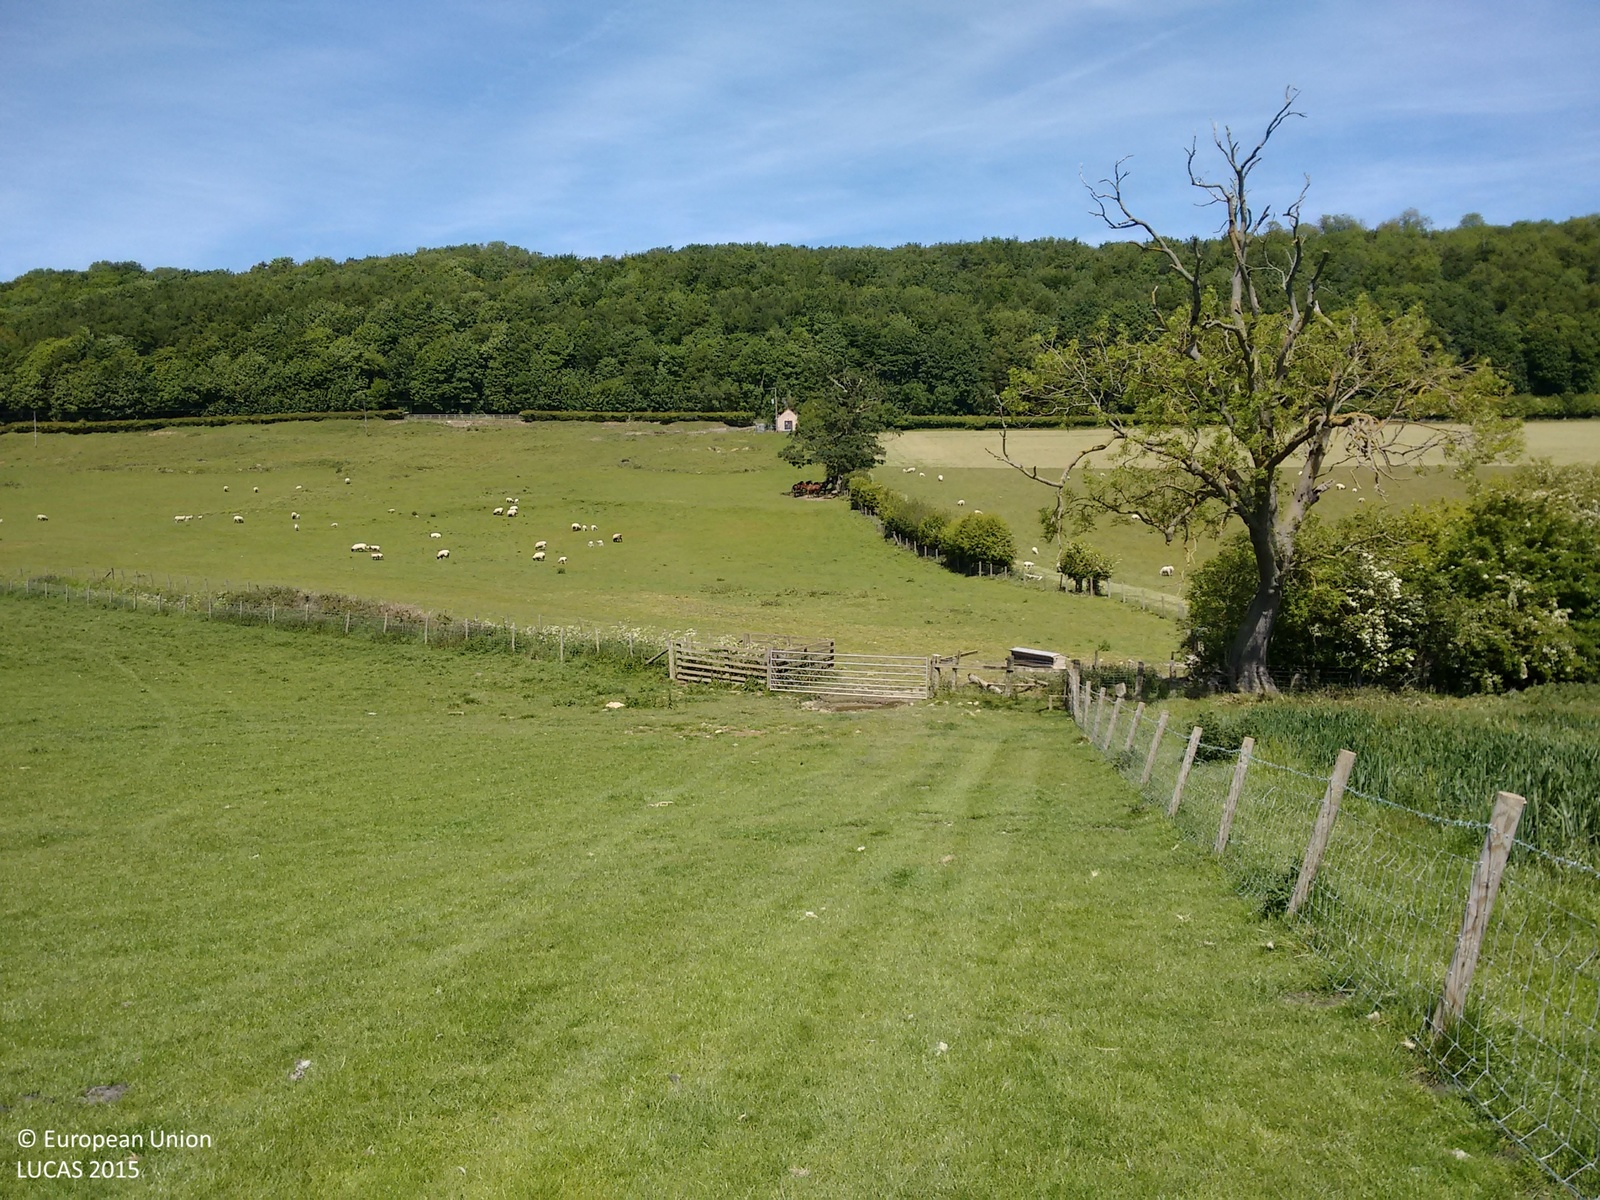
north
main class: Grassland
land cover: Grassland without tree/shrub cover
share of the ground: > 75 %
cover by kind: herbaceous plants 100 %
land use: Agriculture (excluding fallow land and kitchen gardens)
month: June
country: GB
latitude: 54.2003
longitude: -1.0650
